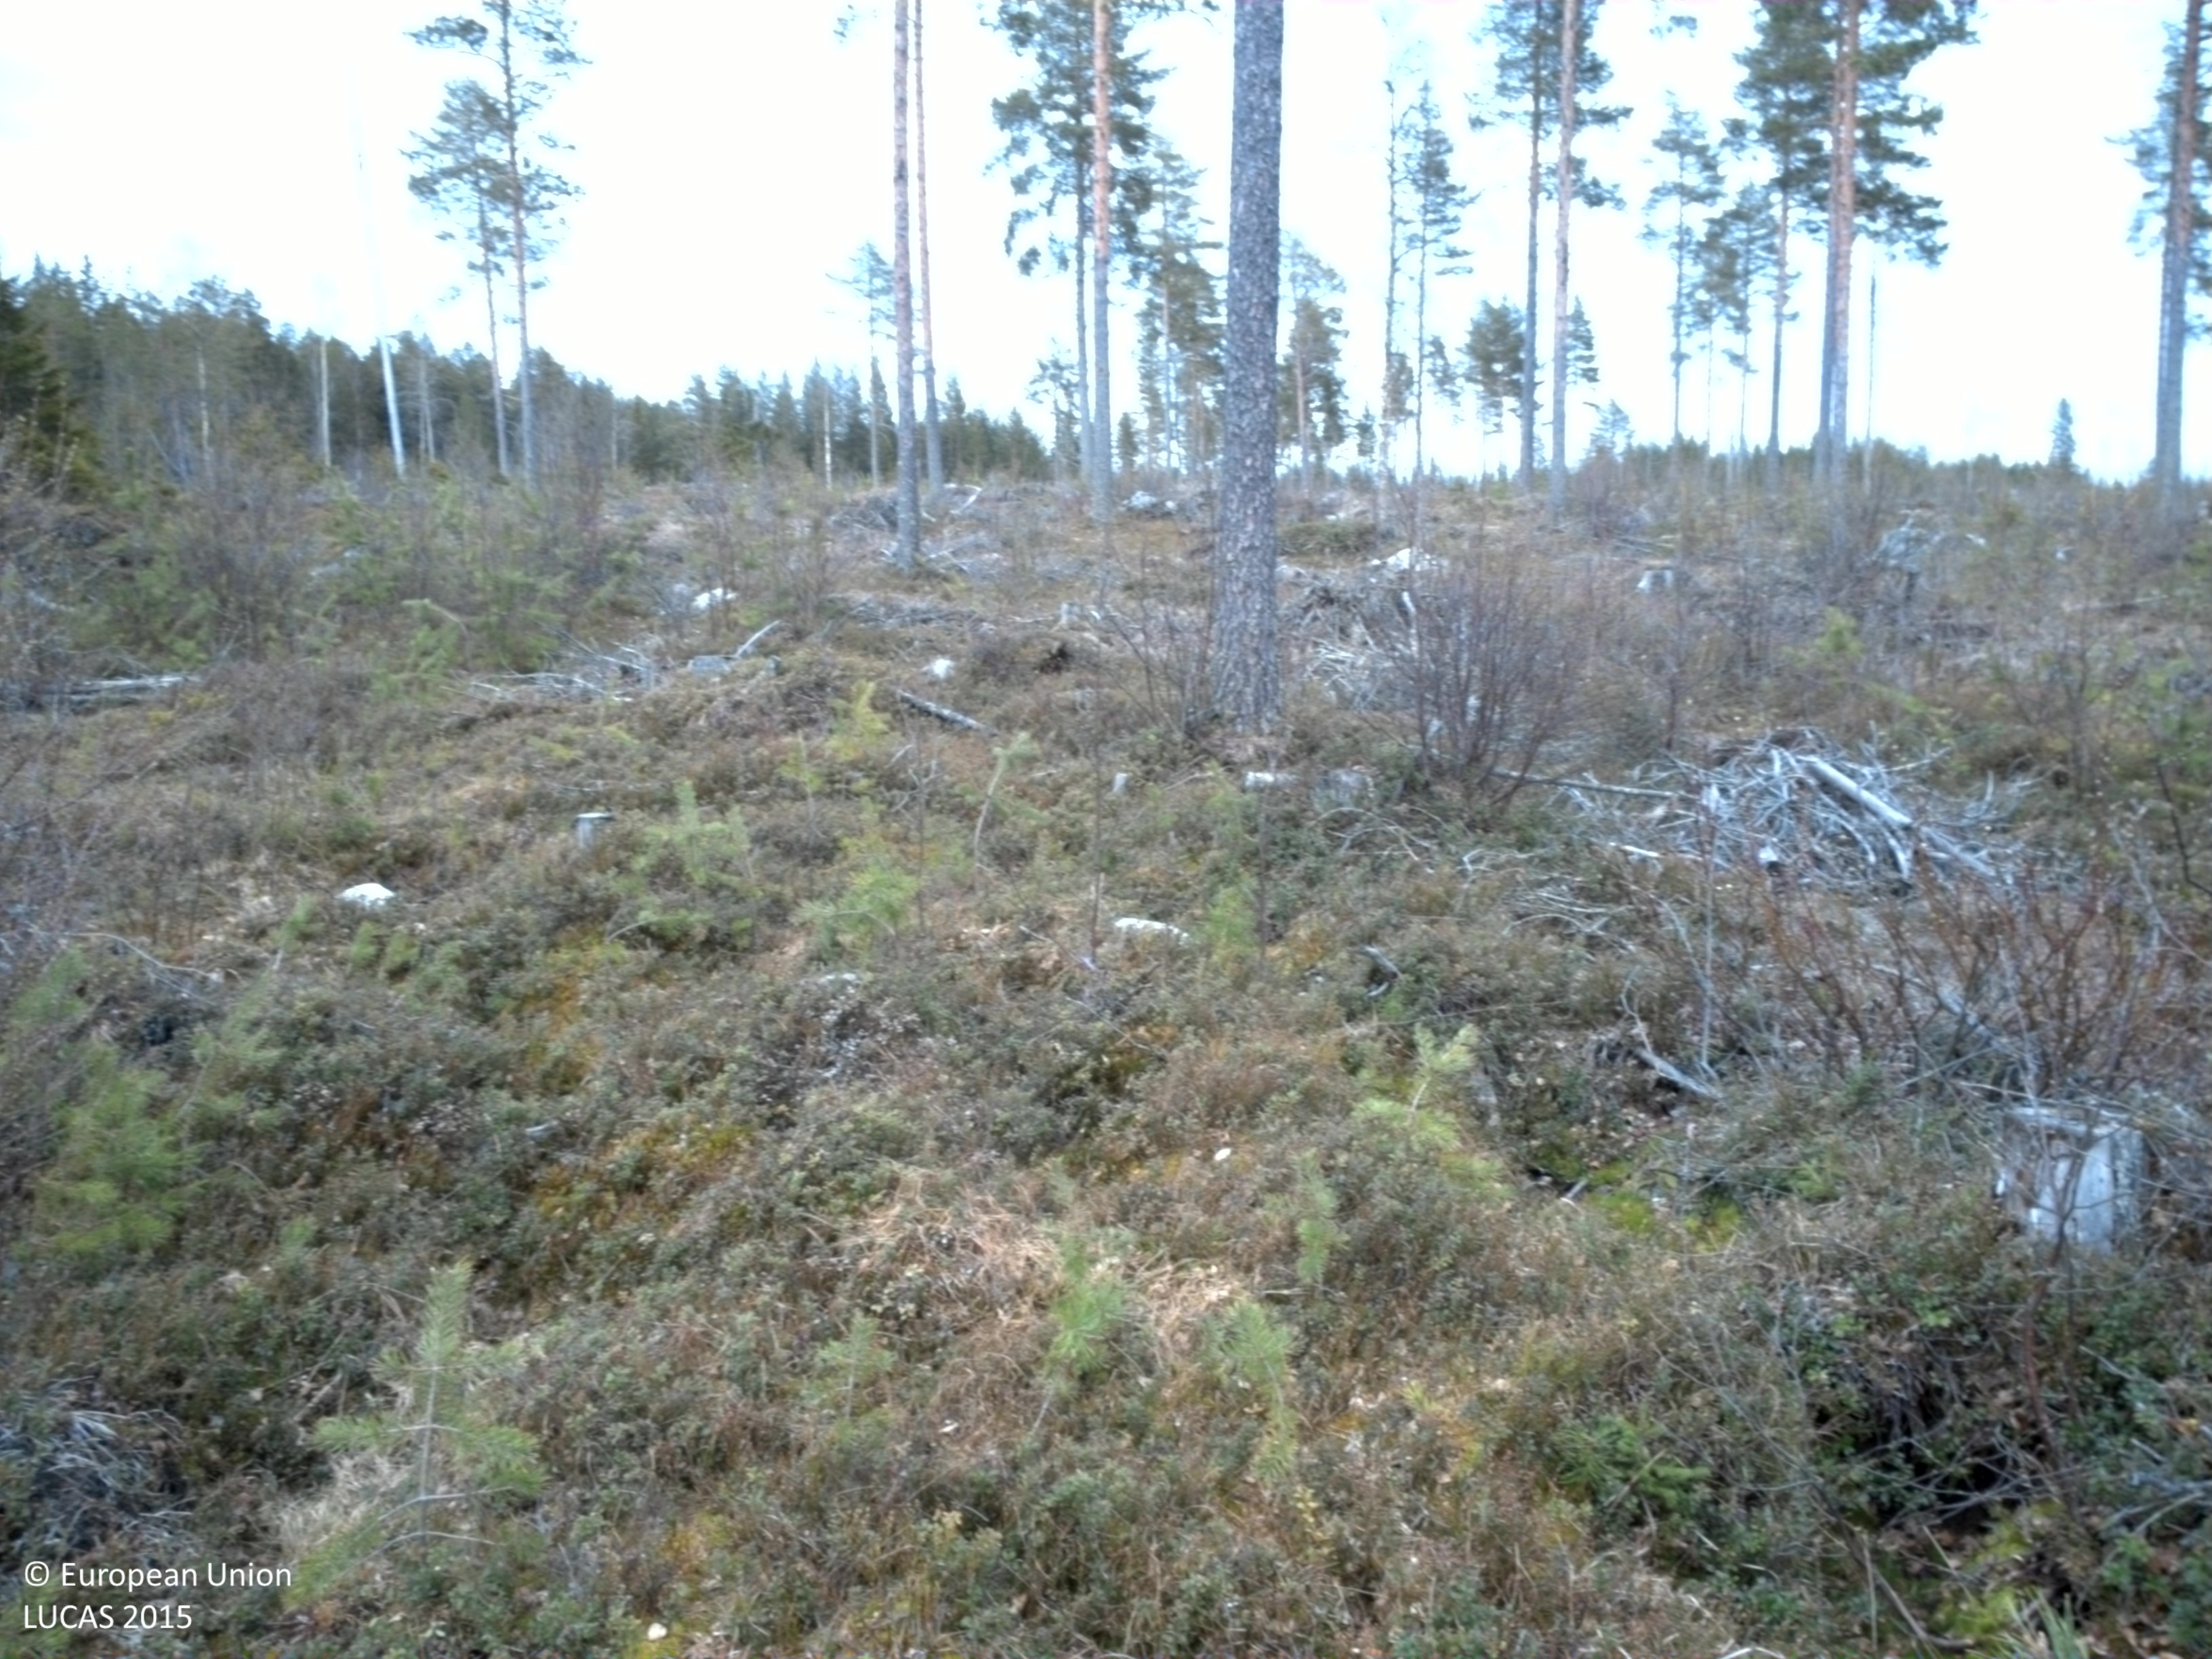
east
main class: Woodland
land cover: Pine dominated mixed woodland
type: boreal forest
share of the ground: 25 - 50 %
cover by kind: shrubs 40 %, coniferous forest trees 30 %, broadleaved forest trees 20 %, herbaceous plants 5 %, lichens and mosses 5 %
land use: Forestry
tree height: < 5 m
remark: Clear cut
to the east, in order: Pine dominated mixed woodland
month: May
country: SE
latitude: 65.8149
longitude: 22.9136
